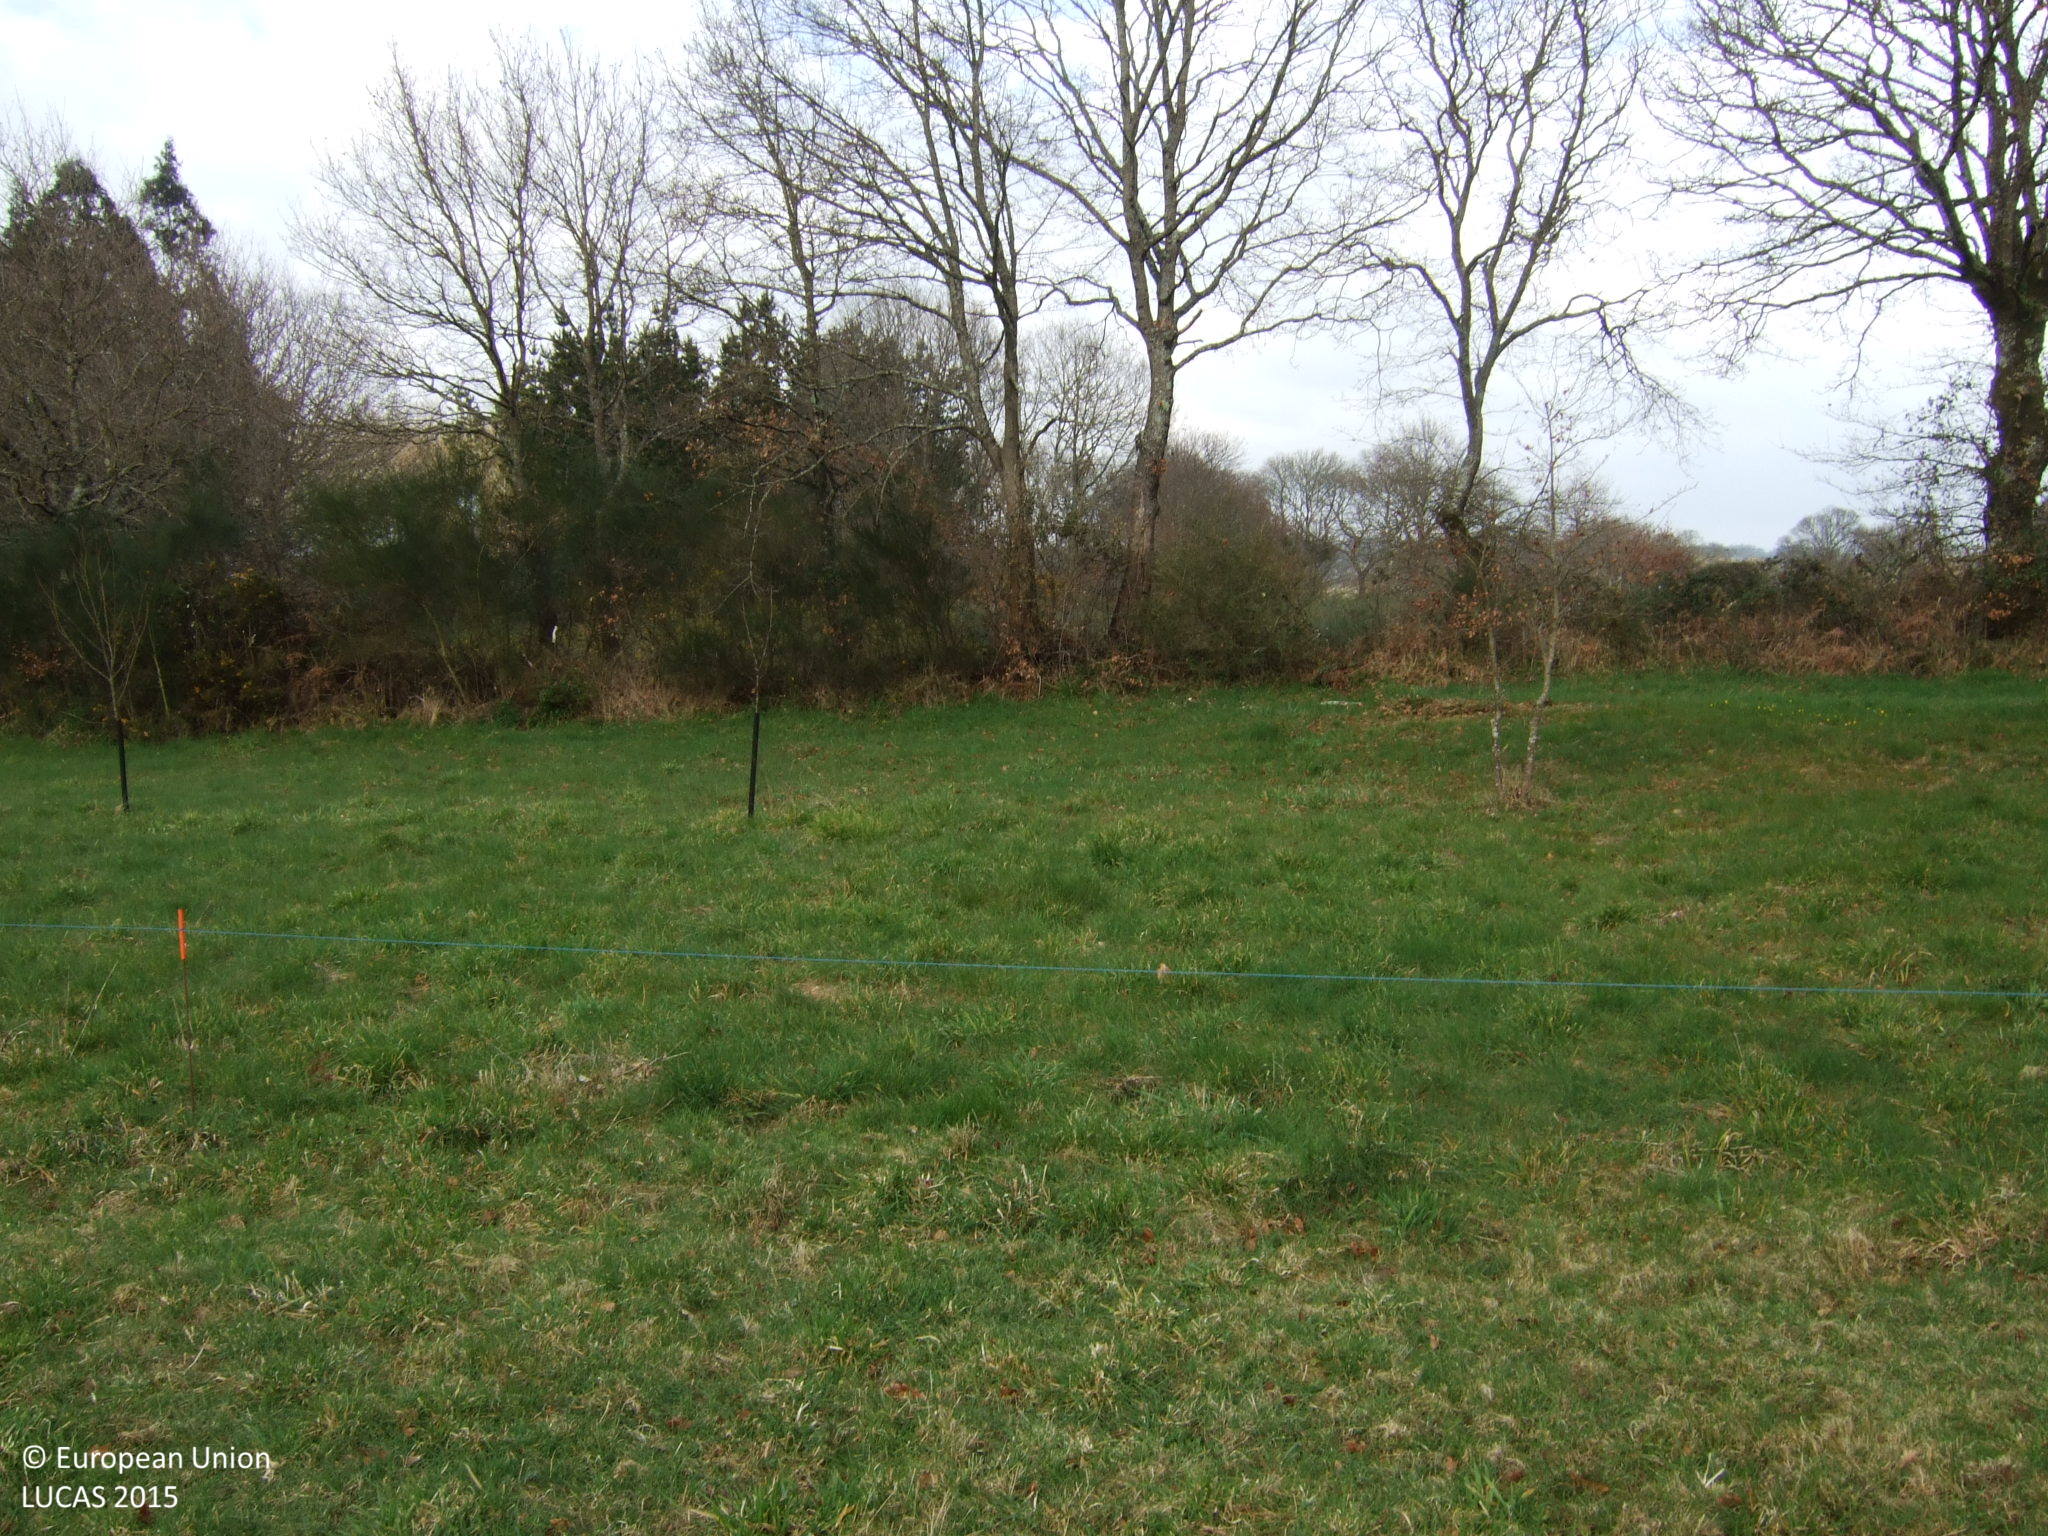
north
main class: Grassland
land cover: Grassland without tree/shrub cover
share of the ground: > 75 %
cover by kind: herbaceous plants 100 %
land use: Agriculture (excluding fallow land and kitchen gardens)
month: March
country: ES
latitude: 42.8671
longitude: -7.9200
